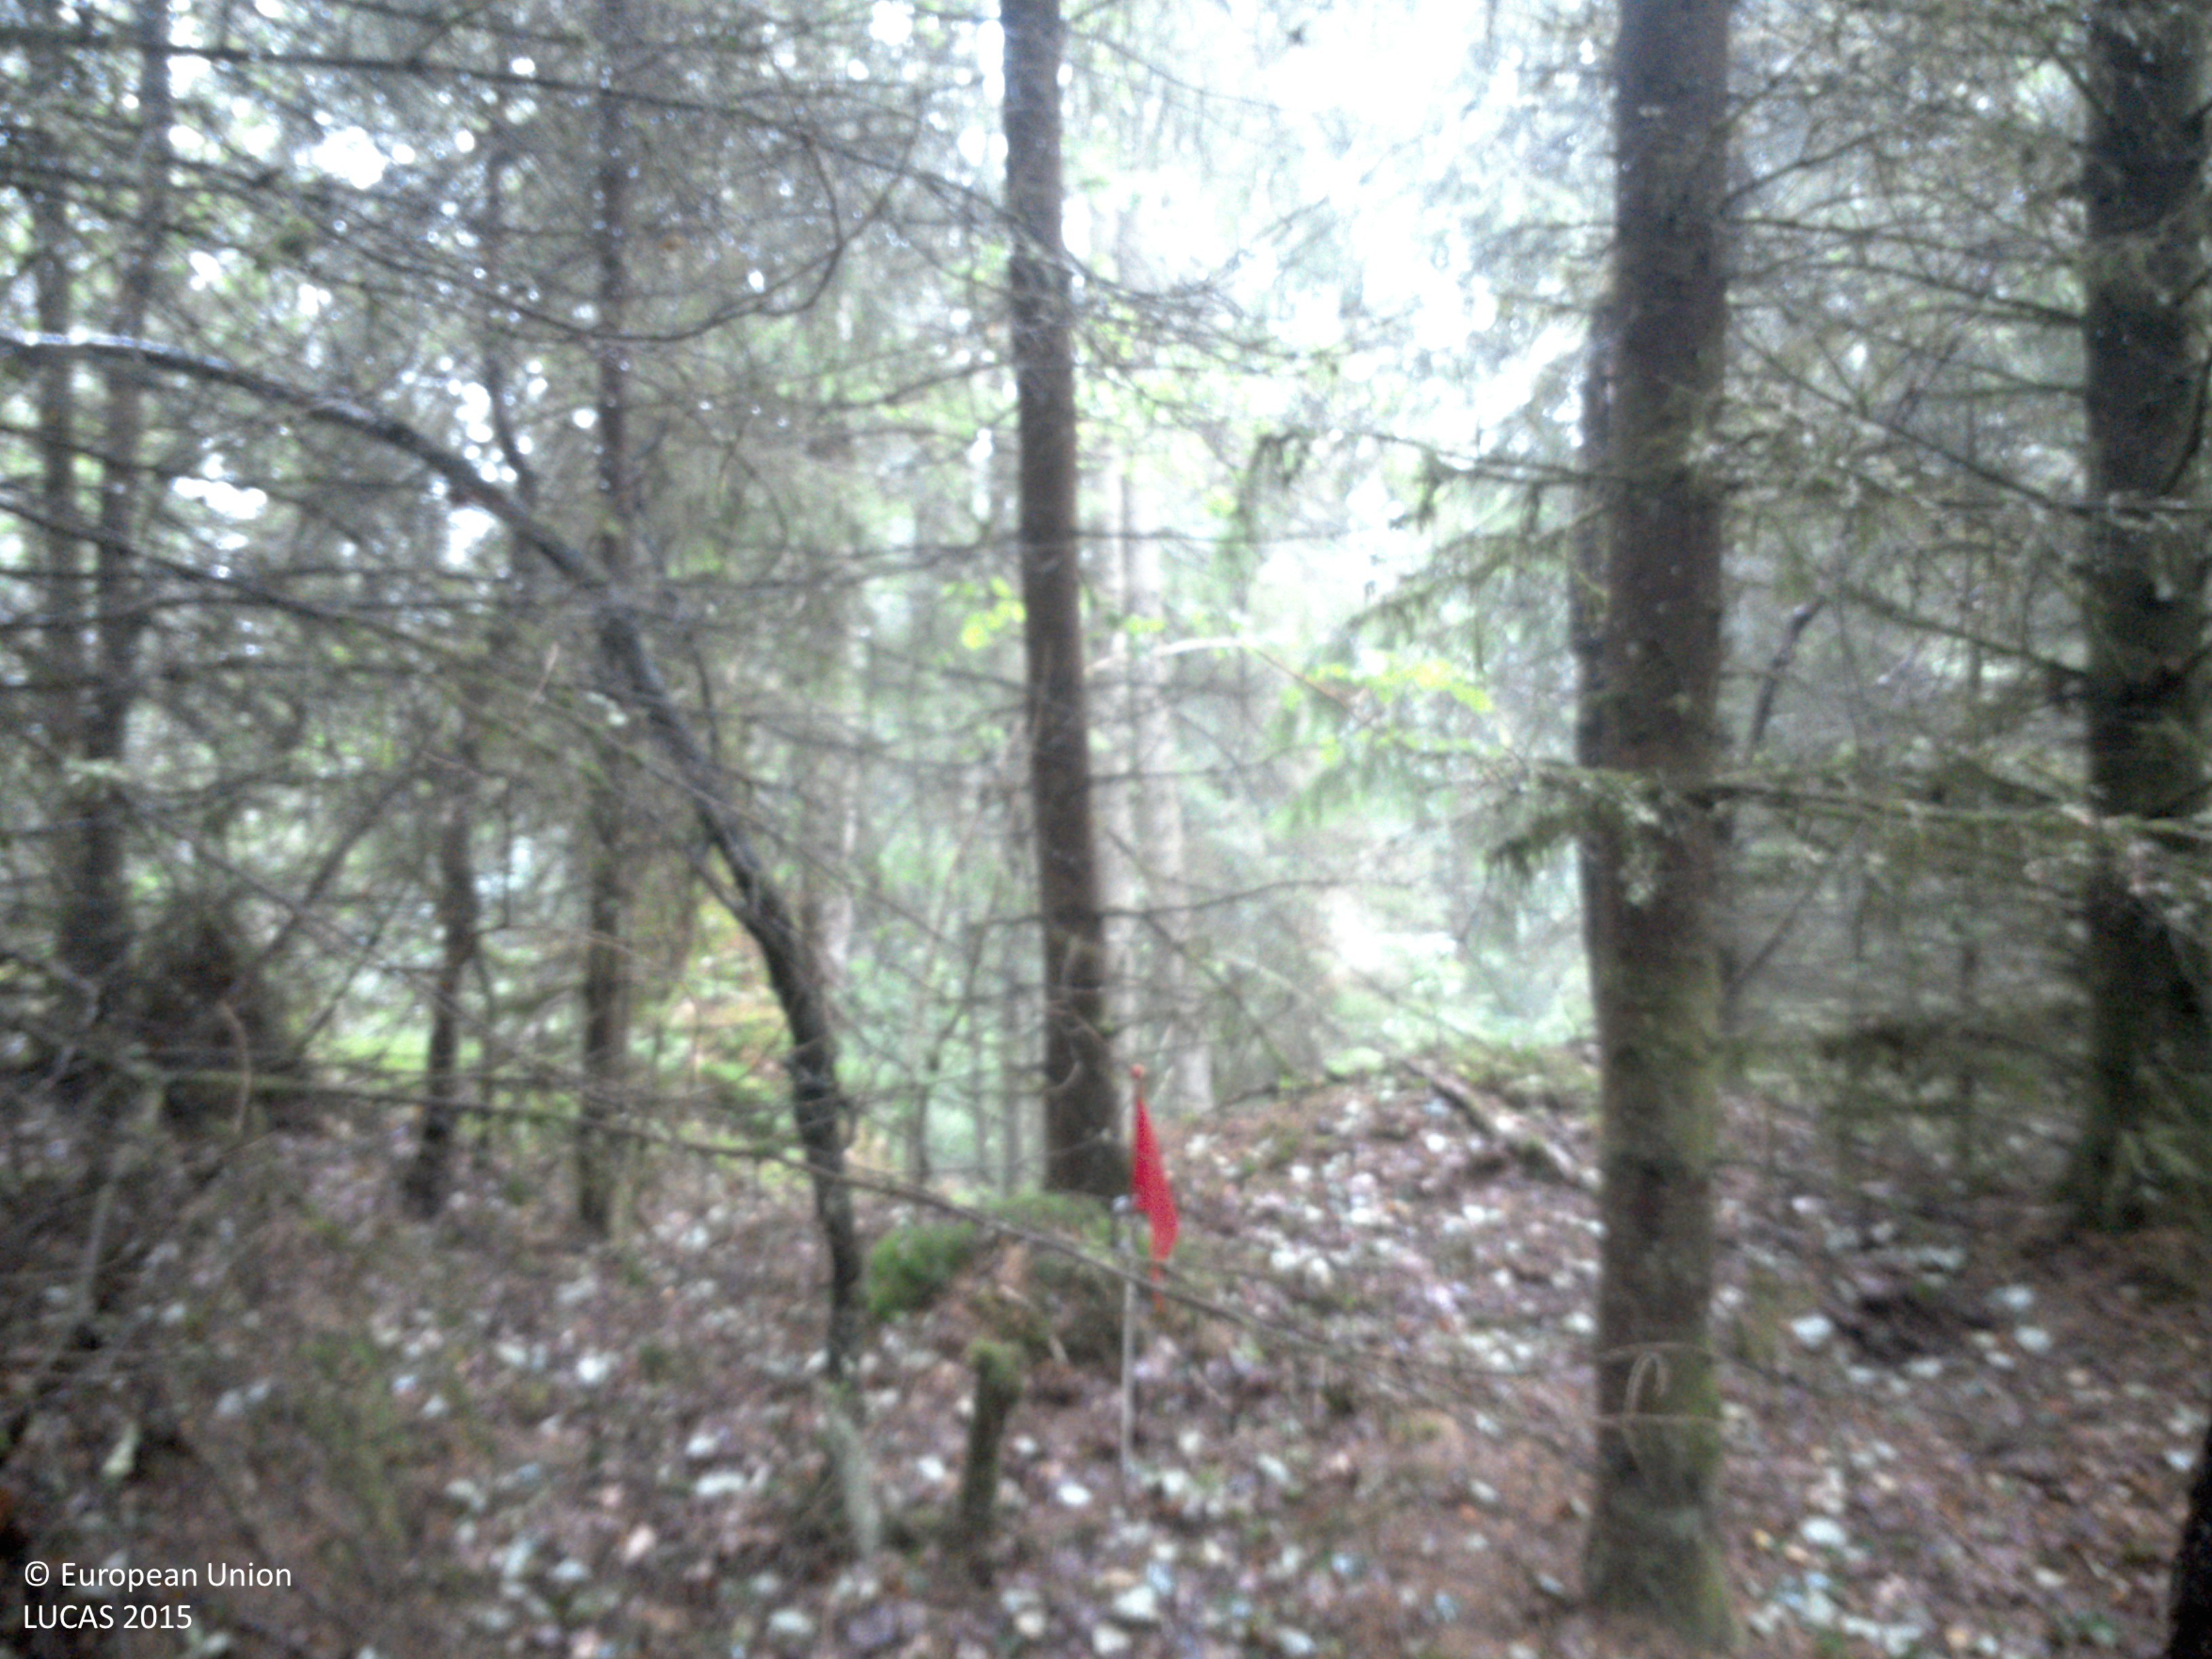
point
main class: Woodland
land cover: Spruce dominated coniferous woodland
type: boreal forest
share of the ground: > 75 %
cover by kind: coniferous forest trees 90 %, lichens and mosses 10 %
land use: Semi-natural and natural areas not in use
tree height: > 5 m
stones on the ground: < 10 %
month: July
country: SE
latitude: 58.6347
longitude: 12.1142
